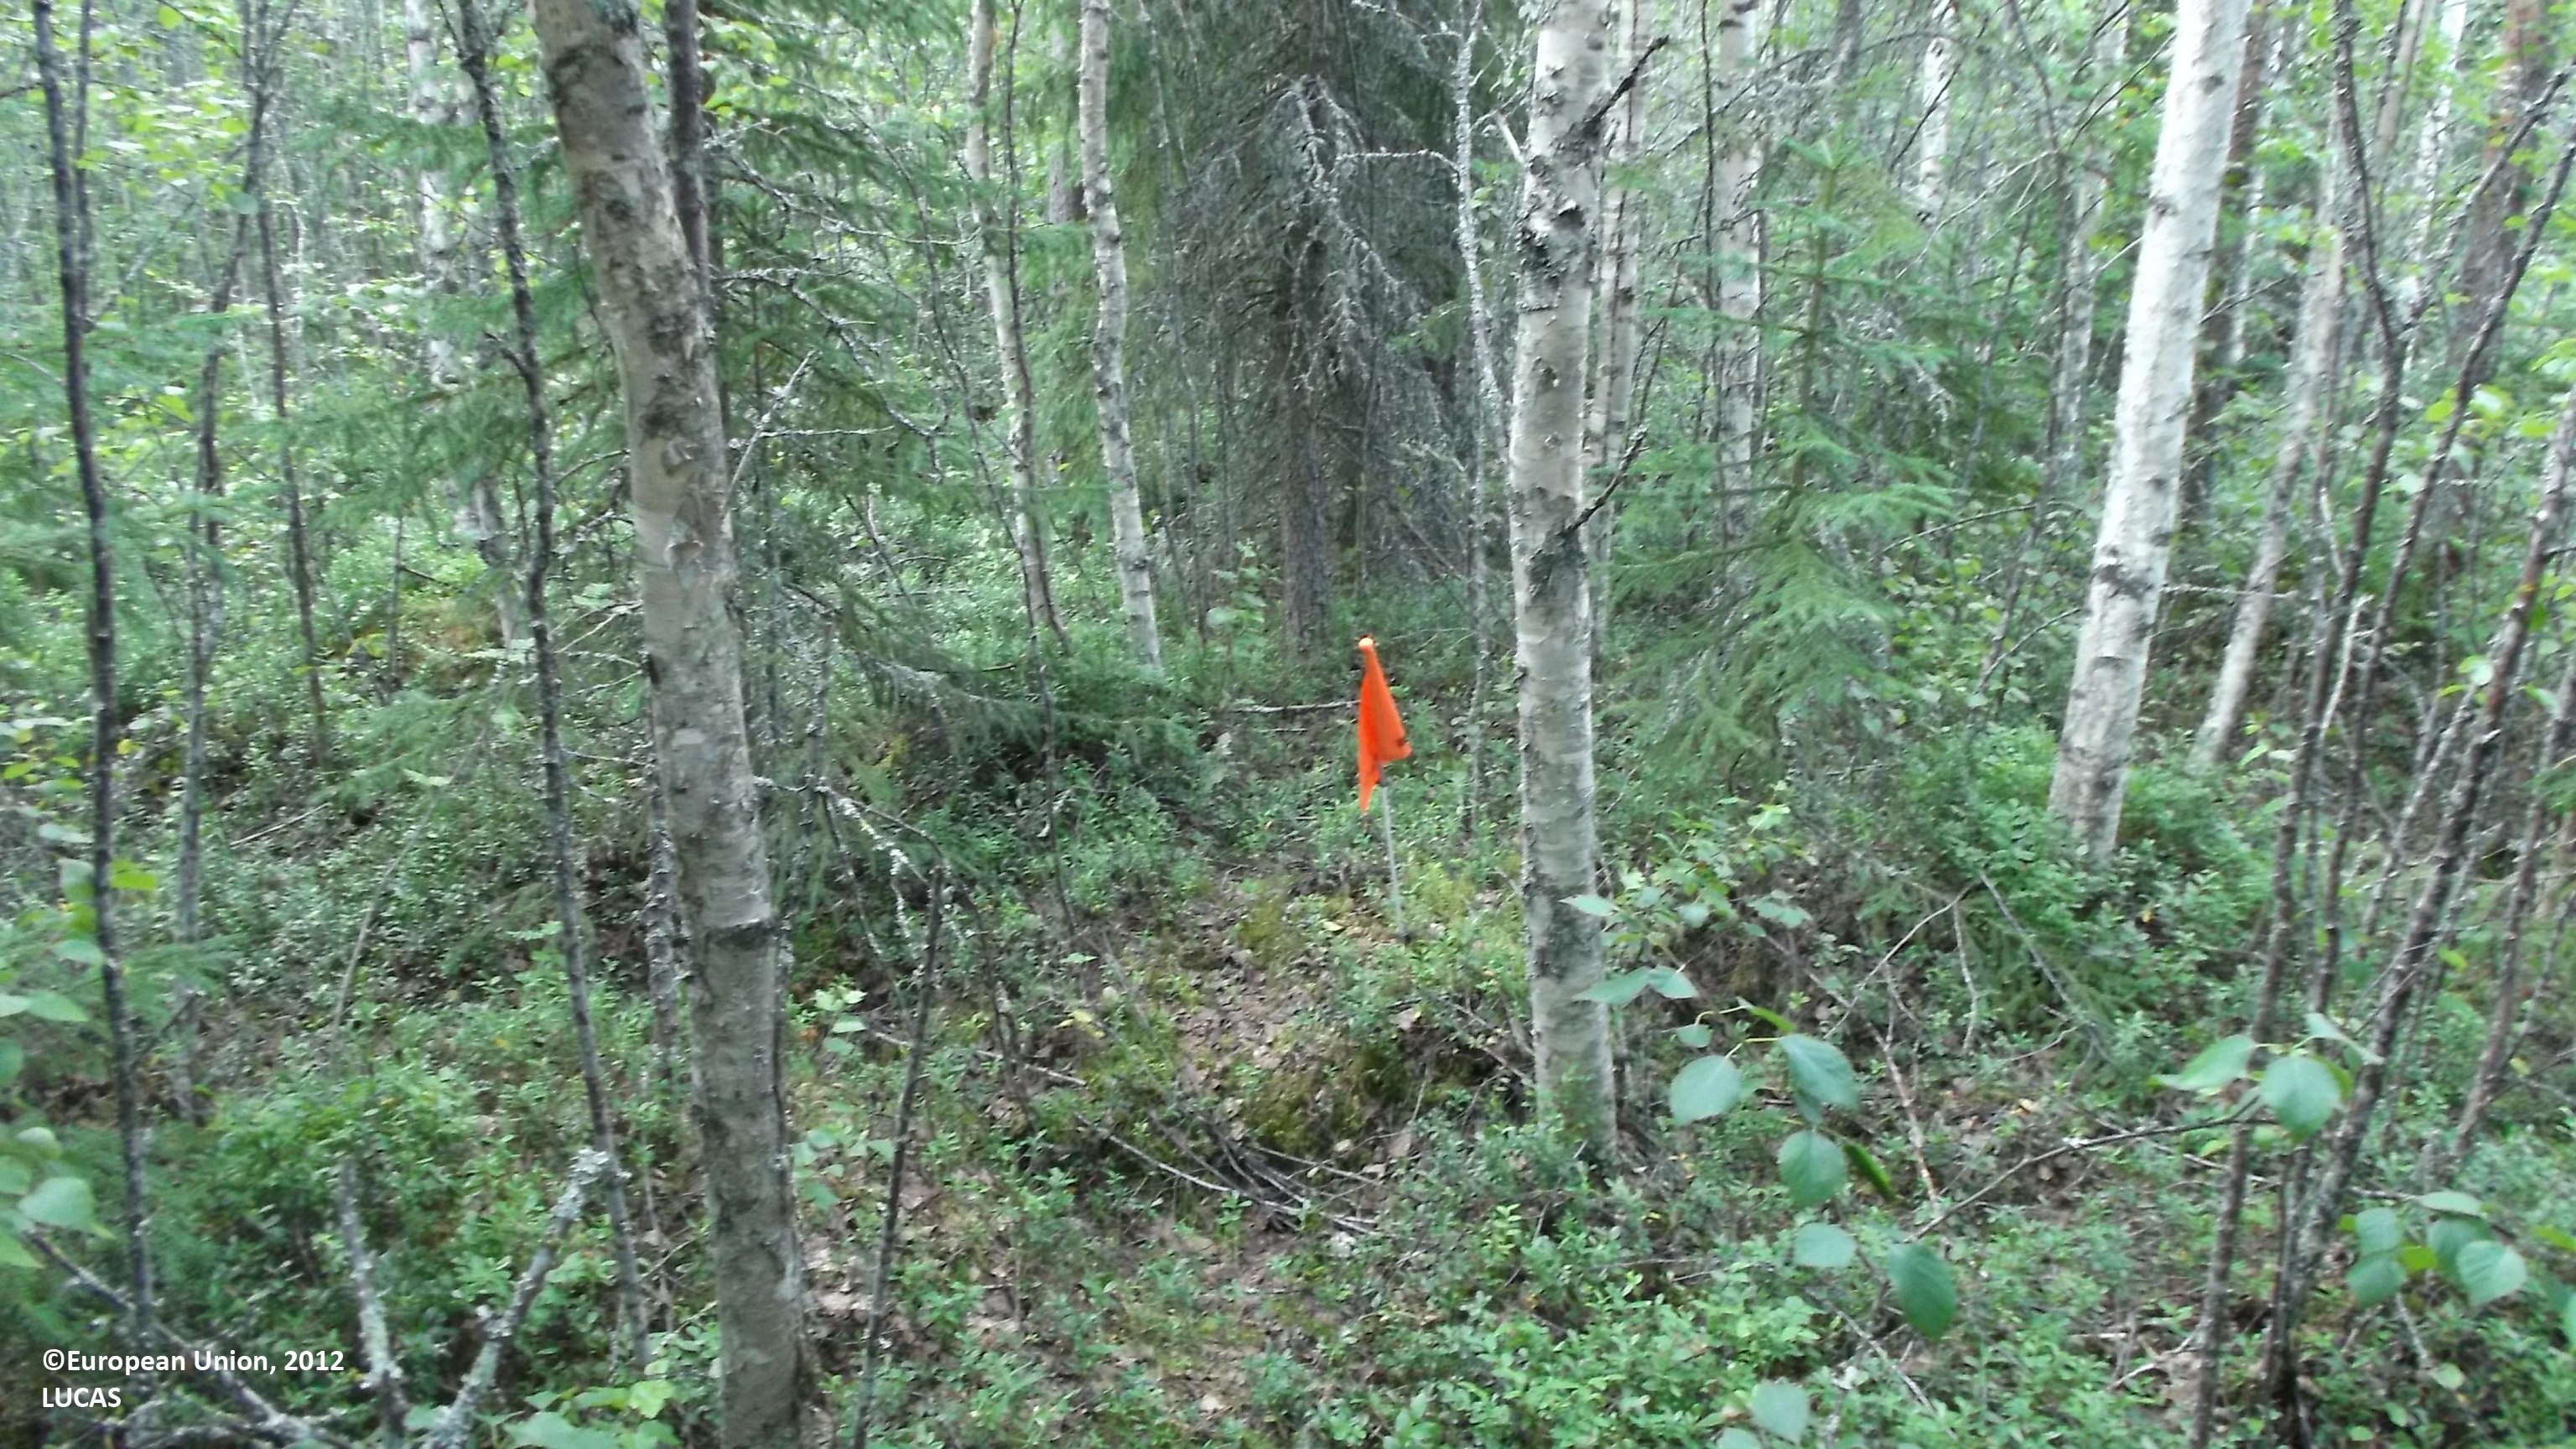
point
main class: Woodland
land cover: Spruce dominated mixed woodland
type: boreal forest
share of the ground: > 75 %
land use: Forestry
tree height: > 5 m
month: July
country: FI
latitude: 63.5915
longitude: 22.9296
